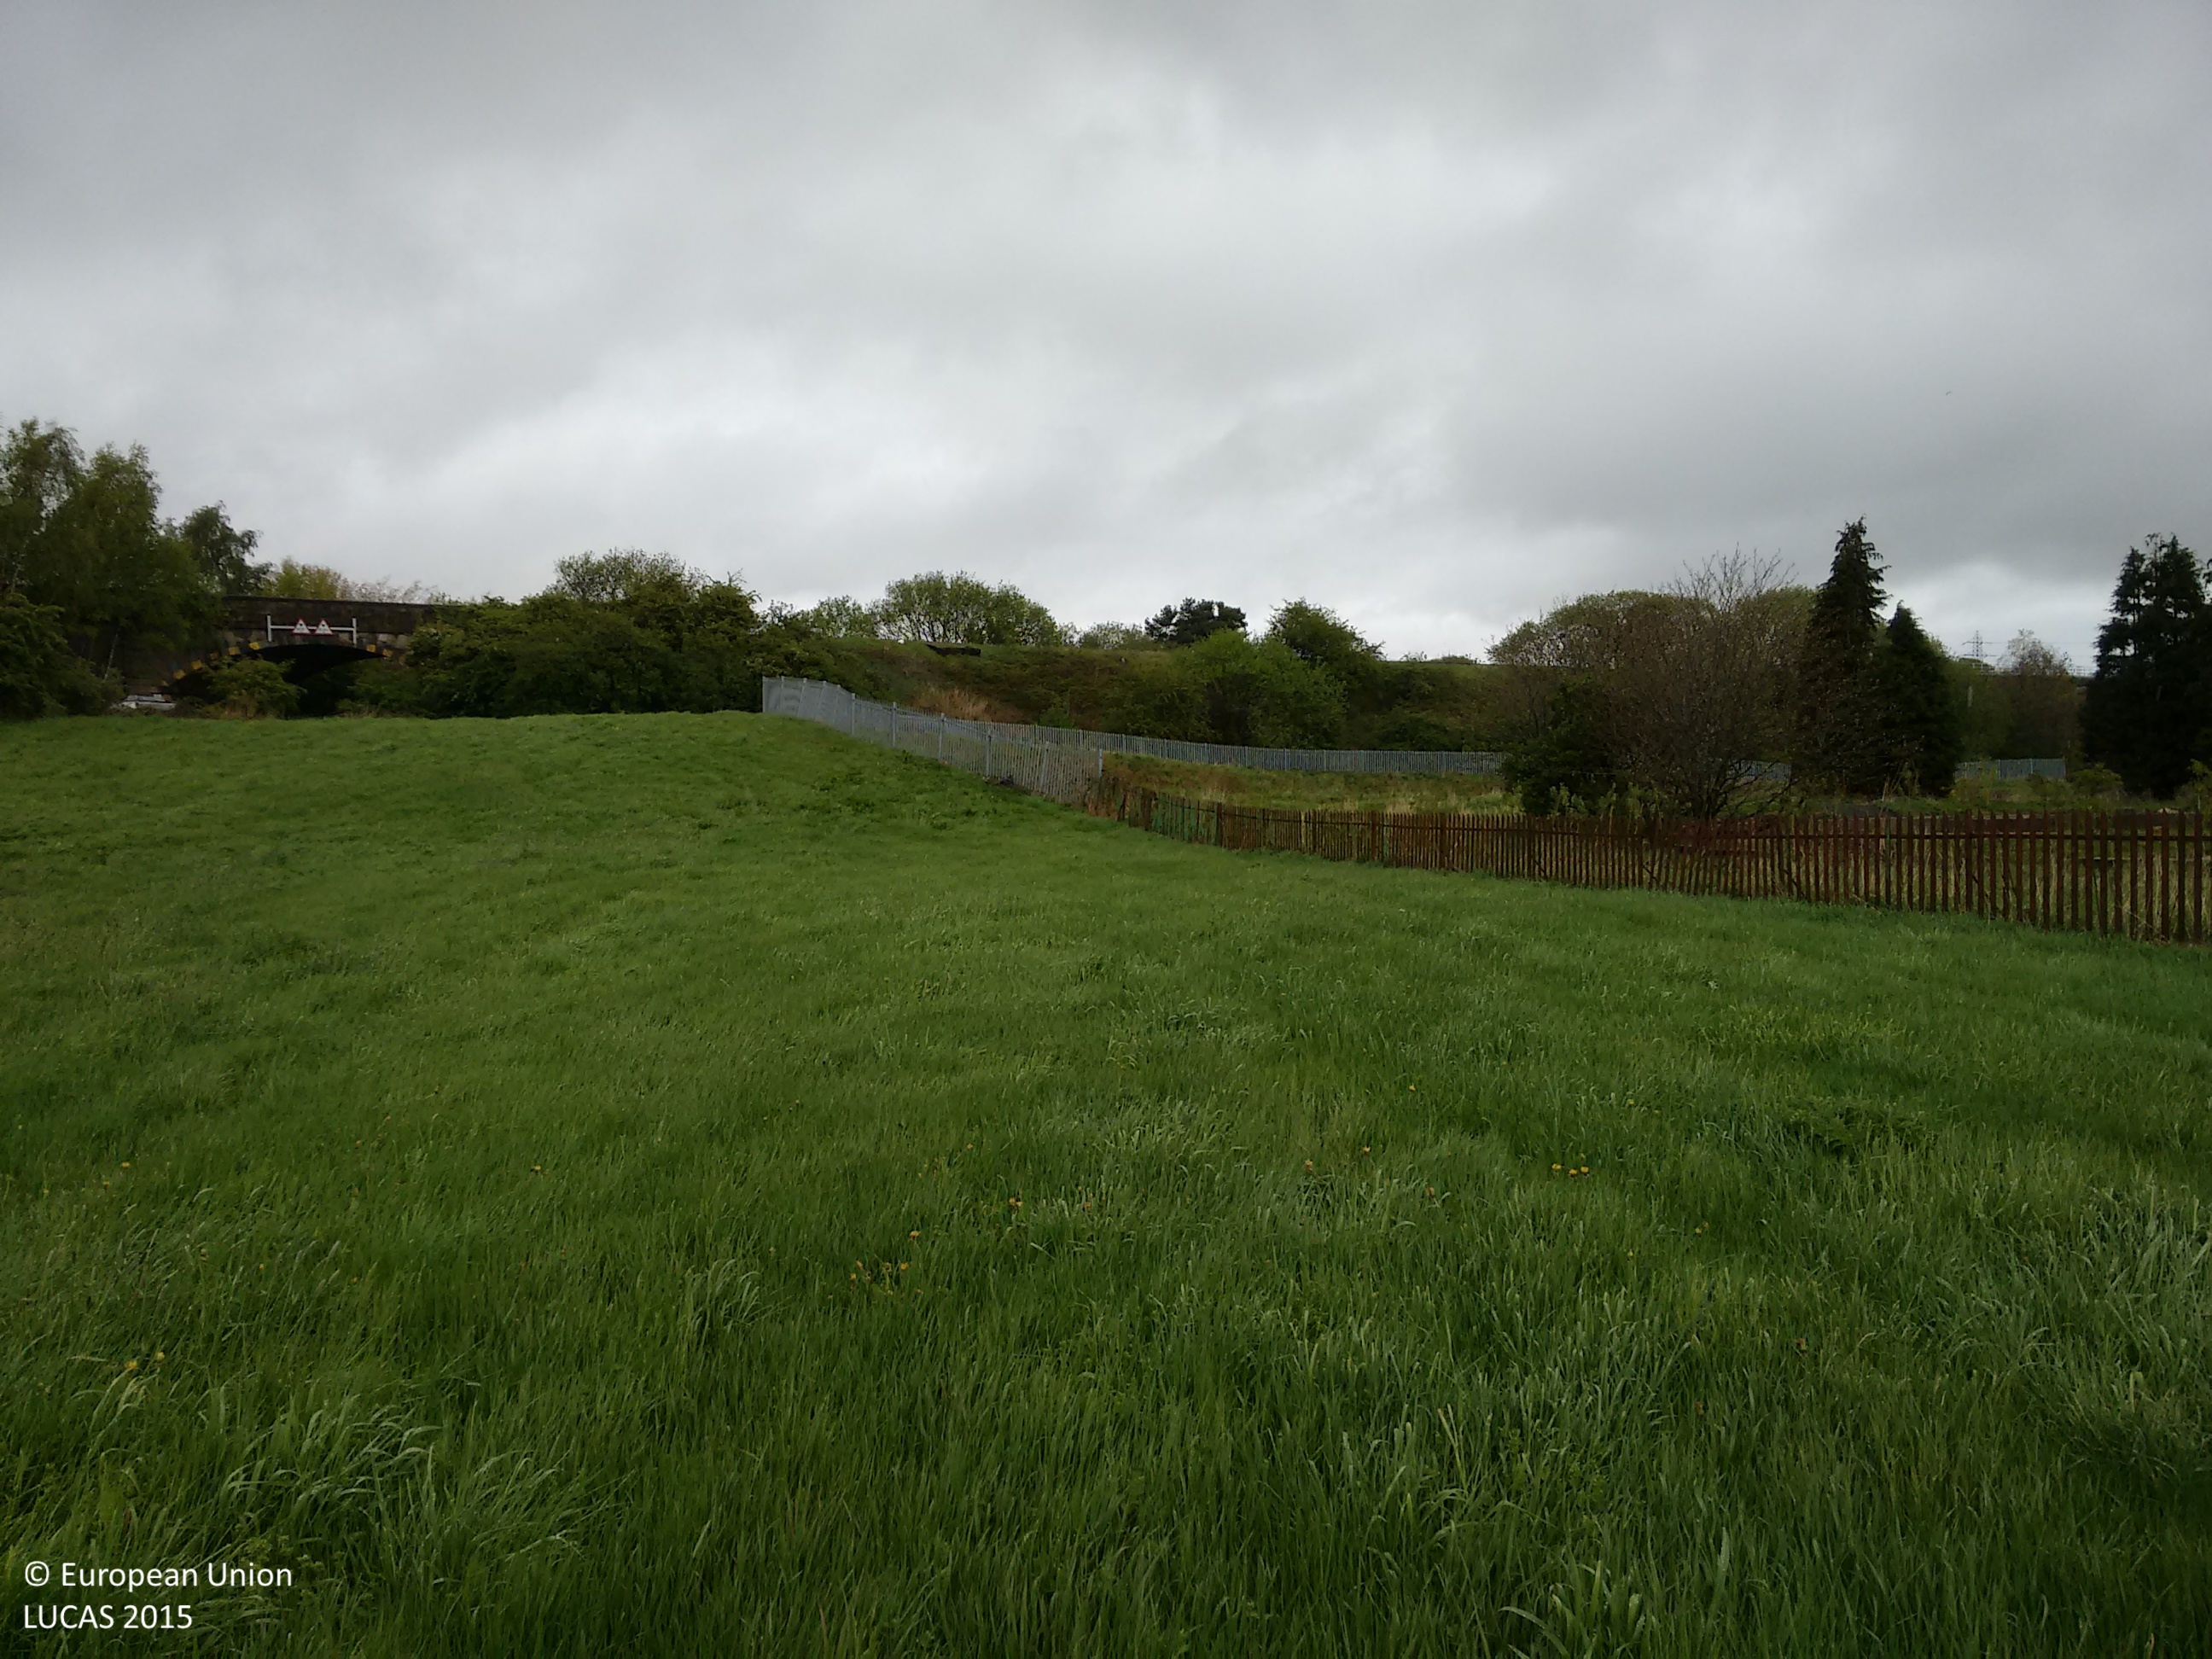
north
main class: Grassland
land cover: Grassland without tree/shrub cover
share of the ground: > 75 %
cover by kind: herbaceous plants 100 %
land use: Agriculture (excluding fallow land and kitchen gardens)
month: May
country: GB
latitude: 55.8112
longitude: -4.3776
